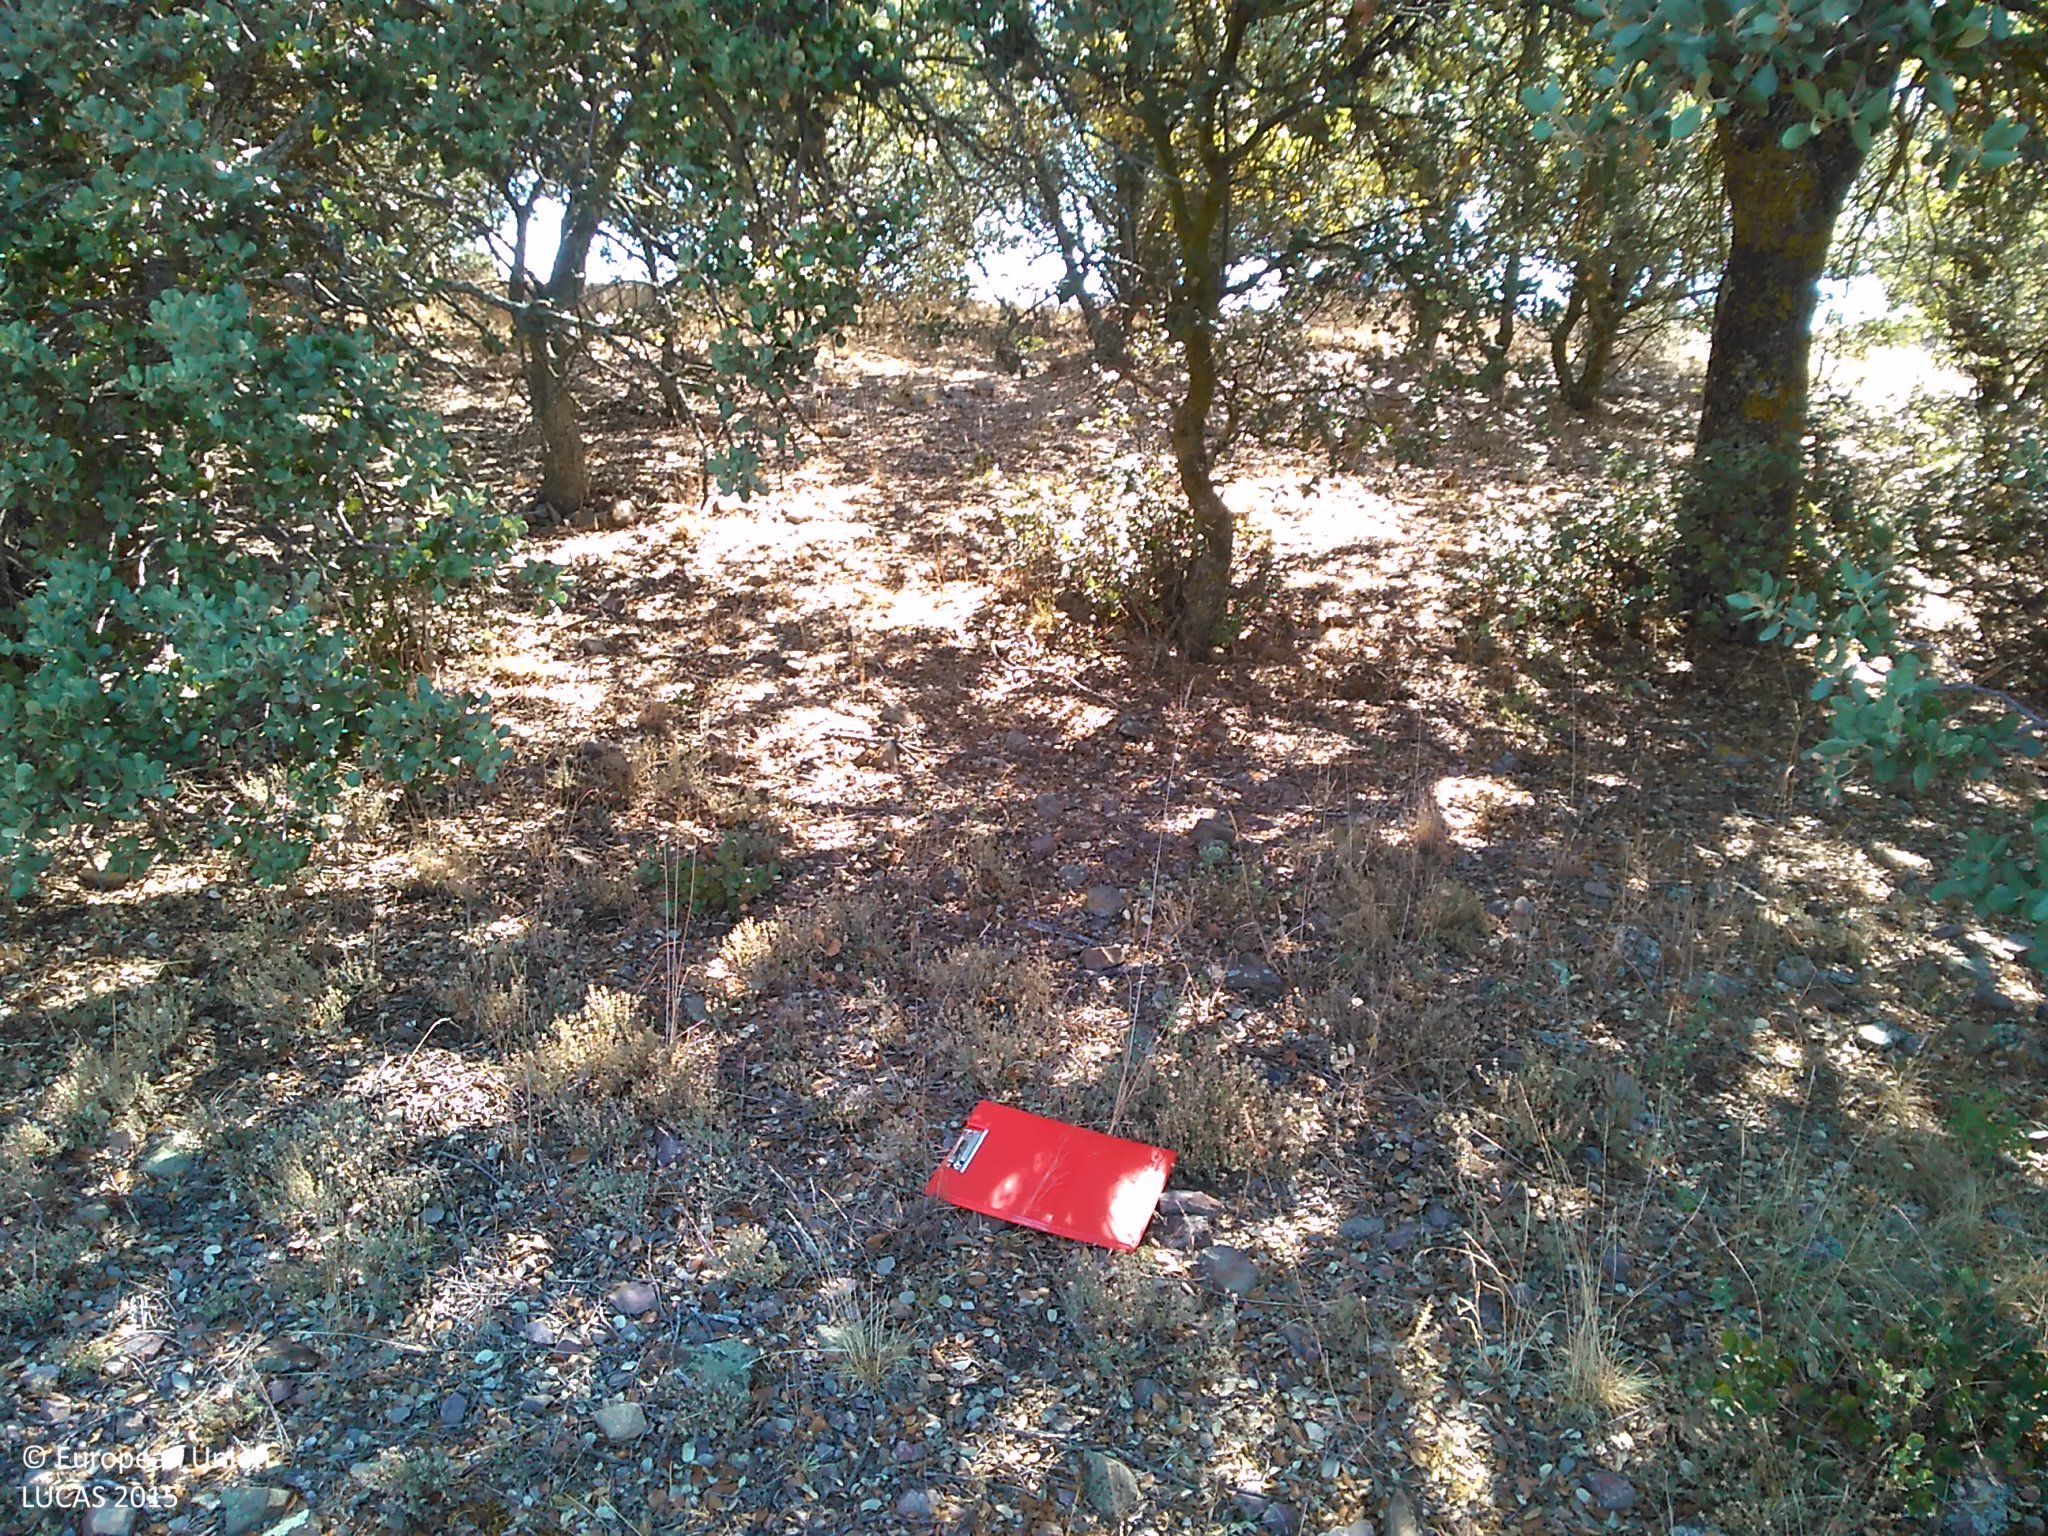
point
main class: Woodland
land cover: Broadleaved woodland
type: broadleaved evergreen forest
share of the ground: 50 - 75 %
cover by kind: broadleaved forest trees 70 %, shrubs 10 %, herbaceous plants 10 %, unconsolidated bare surface 10 %
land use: Semi-natural and natural areas not in use
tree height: > 5 m
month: July
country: ES
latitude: 41.5359
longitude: -2.0047
